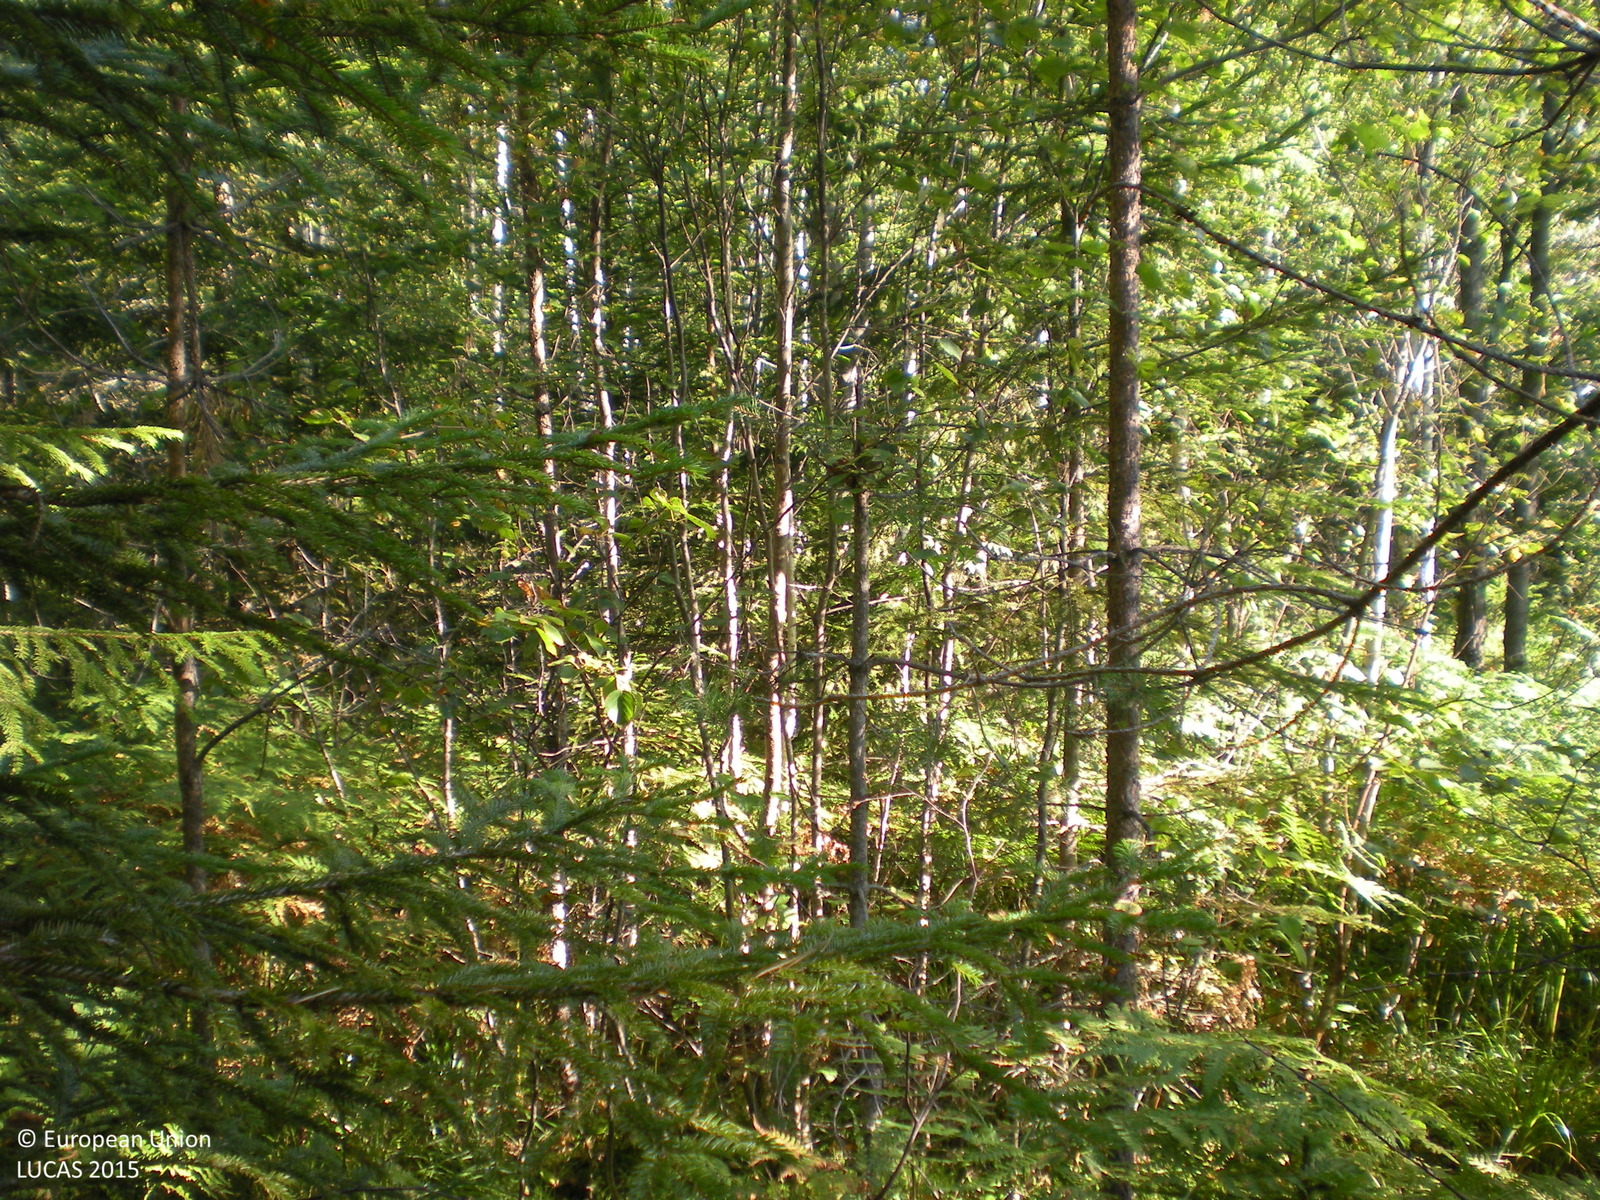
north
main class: Woodland
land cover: Spruce dominated mixed woodland
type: boreal forest
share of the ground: > 75 %
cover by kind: coniferous forest trees 55 %, broadleaved forest trees 25 %, herbaceous plants 10 %, shrubs 5 %, lichens and mosses 5 %
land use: Forestry
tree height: > 5 m
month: August
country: SE
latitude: 60.6293
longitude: 17.2094
